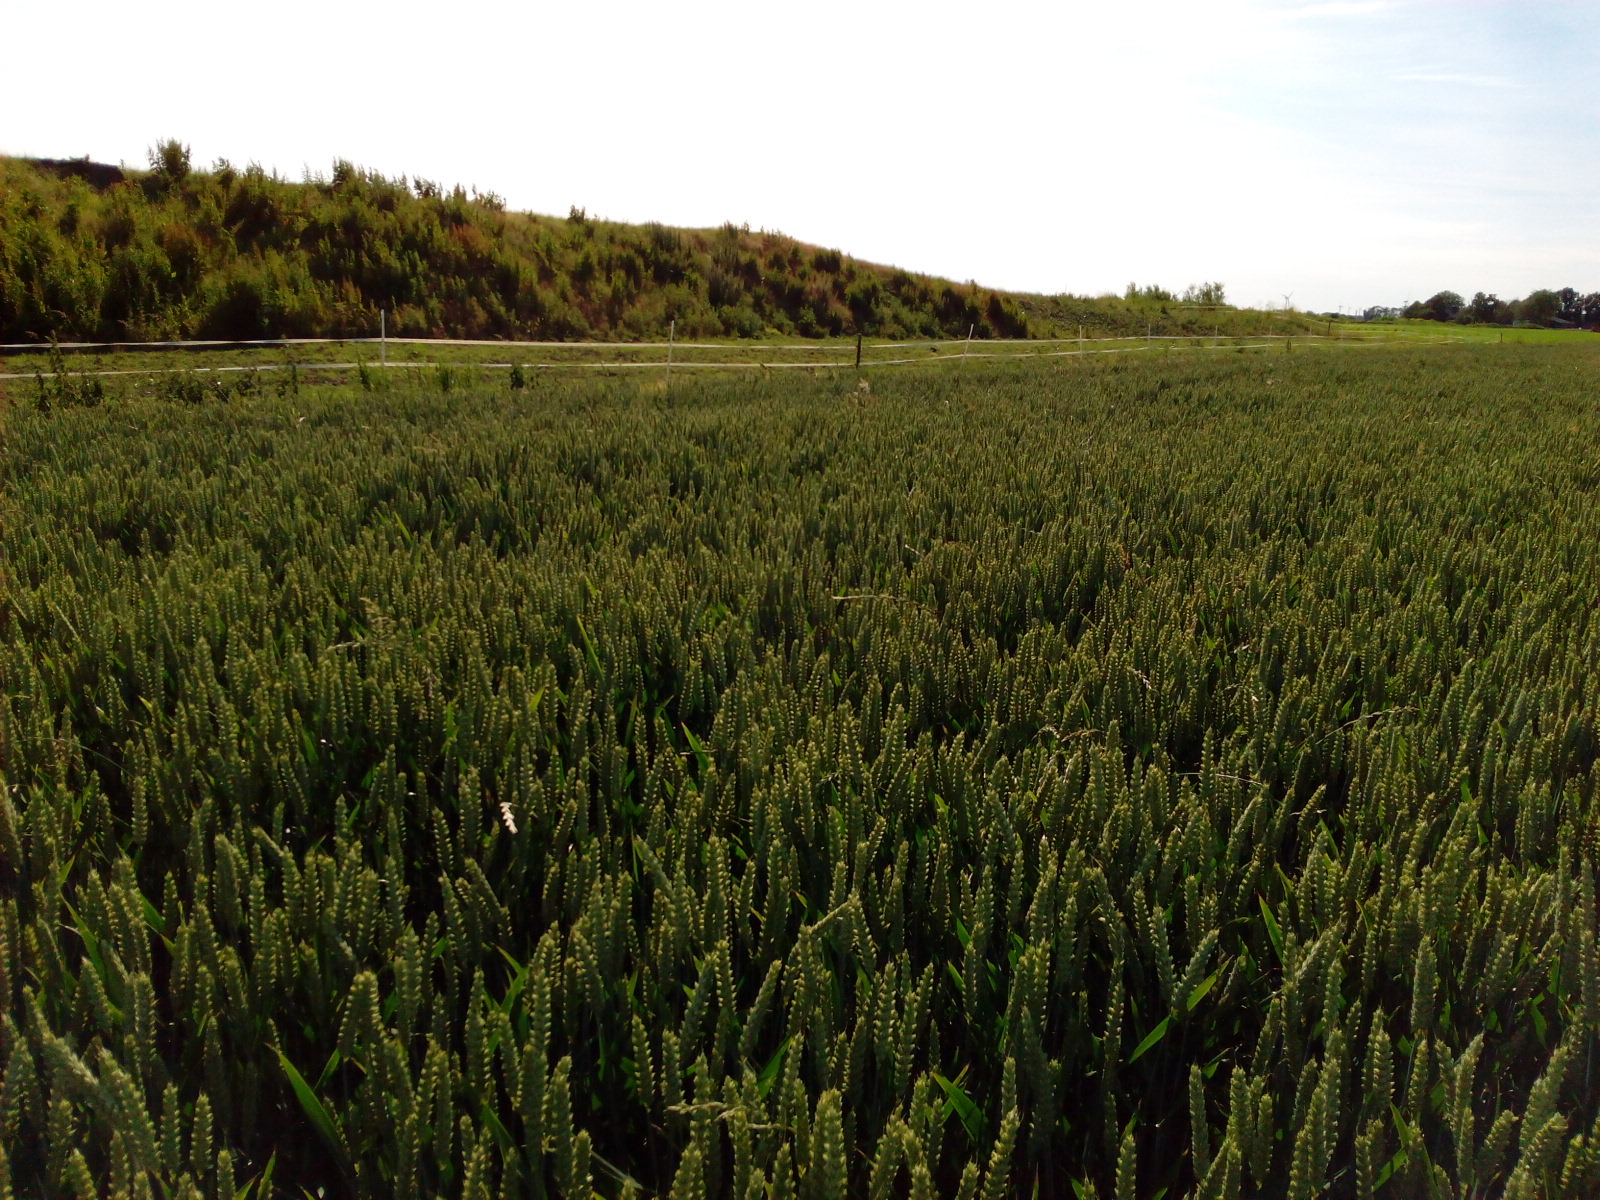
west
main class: Cropland
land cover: Common wheat
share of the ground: > 75 %
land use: Agriculture (excluding fallow land and kitchen gardens)
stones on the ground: < 10 %
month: June
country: NL
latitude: 52.5498
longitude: 5.6482
